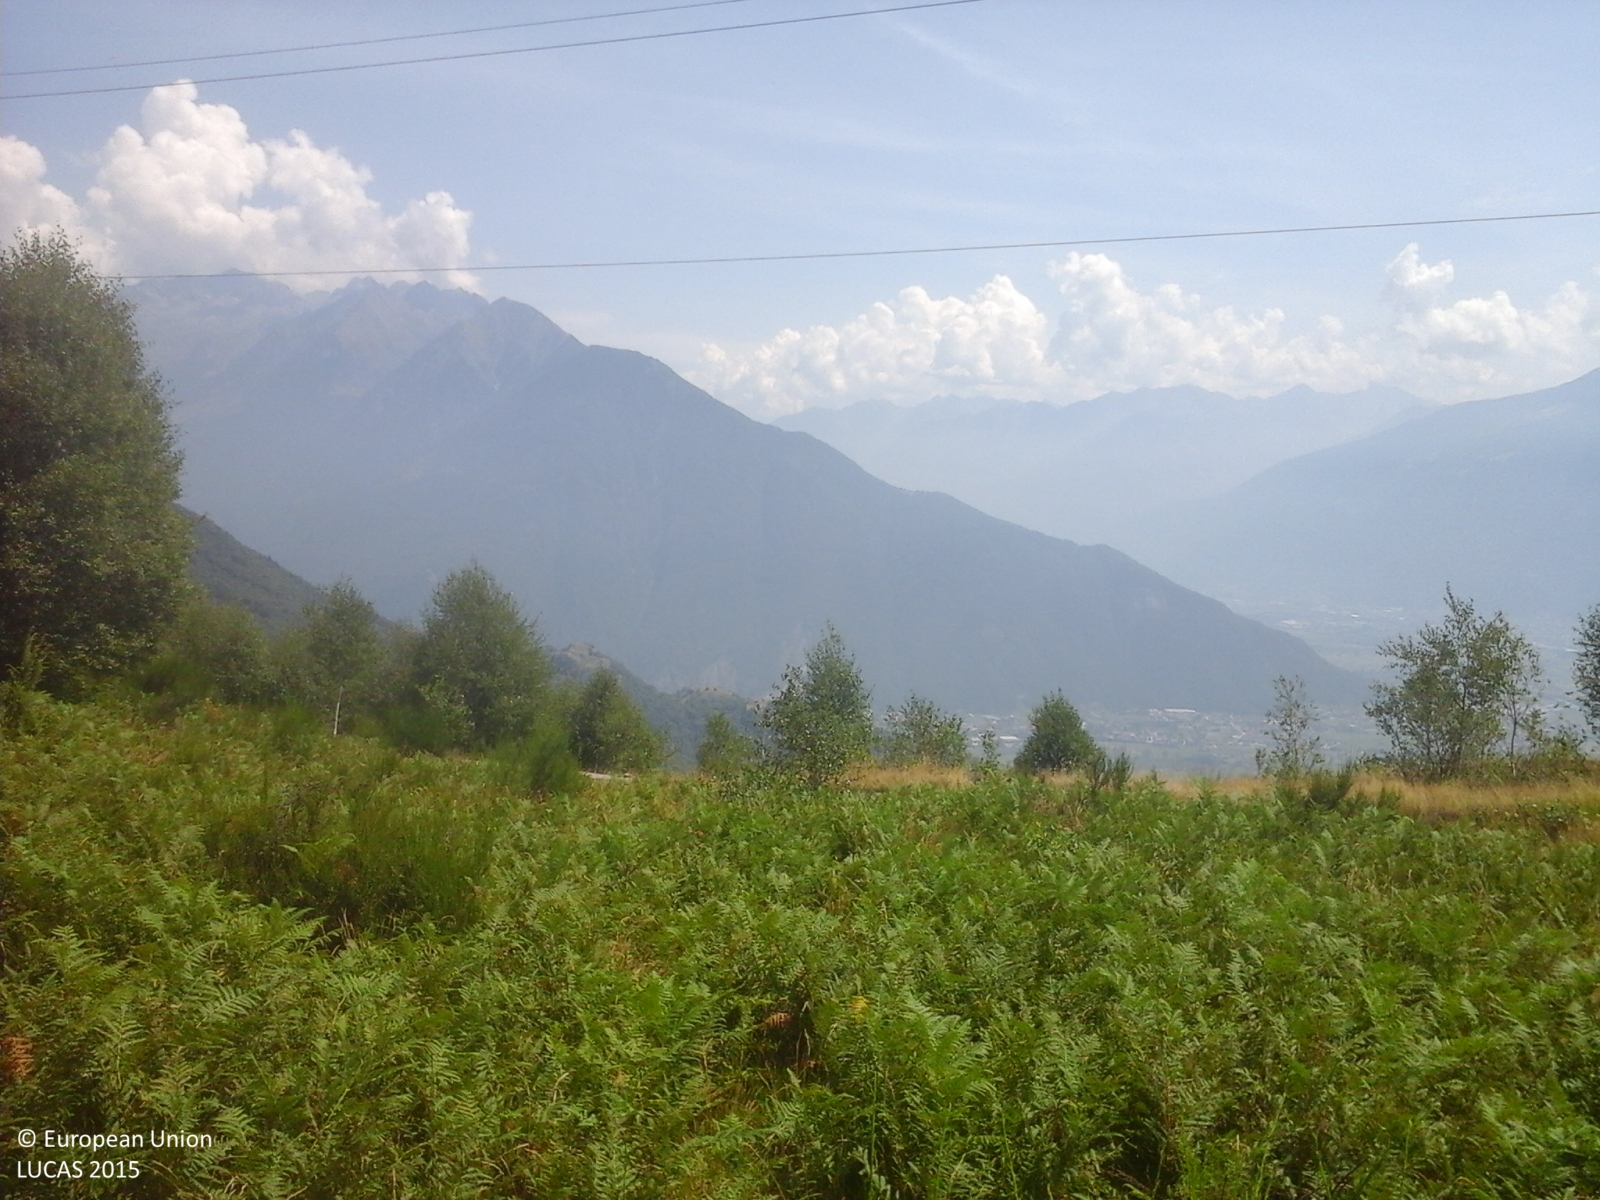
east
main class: Shrubland
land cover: Shrubland without tree cover
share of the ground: > 75 %
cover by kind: herbaceous plants 80 %, shrubs 20 %
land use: Semi-natural and natural areas not in use
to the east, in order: Shrubland without tree cover; Electric lines; Paved roads, cycling and walking lanes; Grassland with sparse tree/shrub cover; Abandoned hedges; Paved roads, cycling and walking lanes; Grassland without tree/shrub cover; Lines of trees; Paved roads, cycling and walking lanes; Grassland with sparse tree/shrub cover
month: August
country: IT
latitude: 46.1872
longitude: 9.3660
